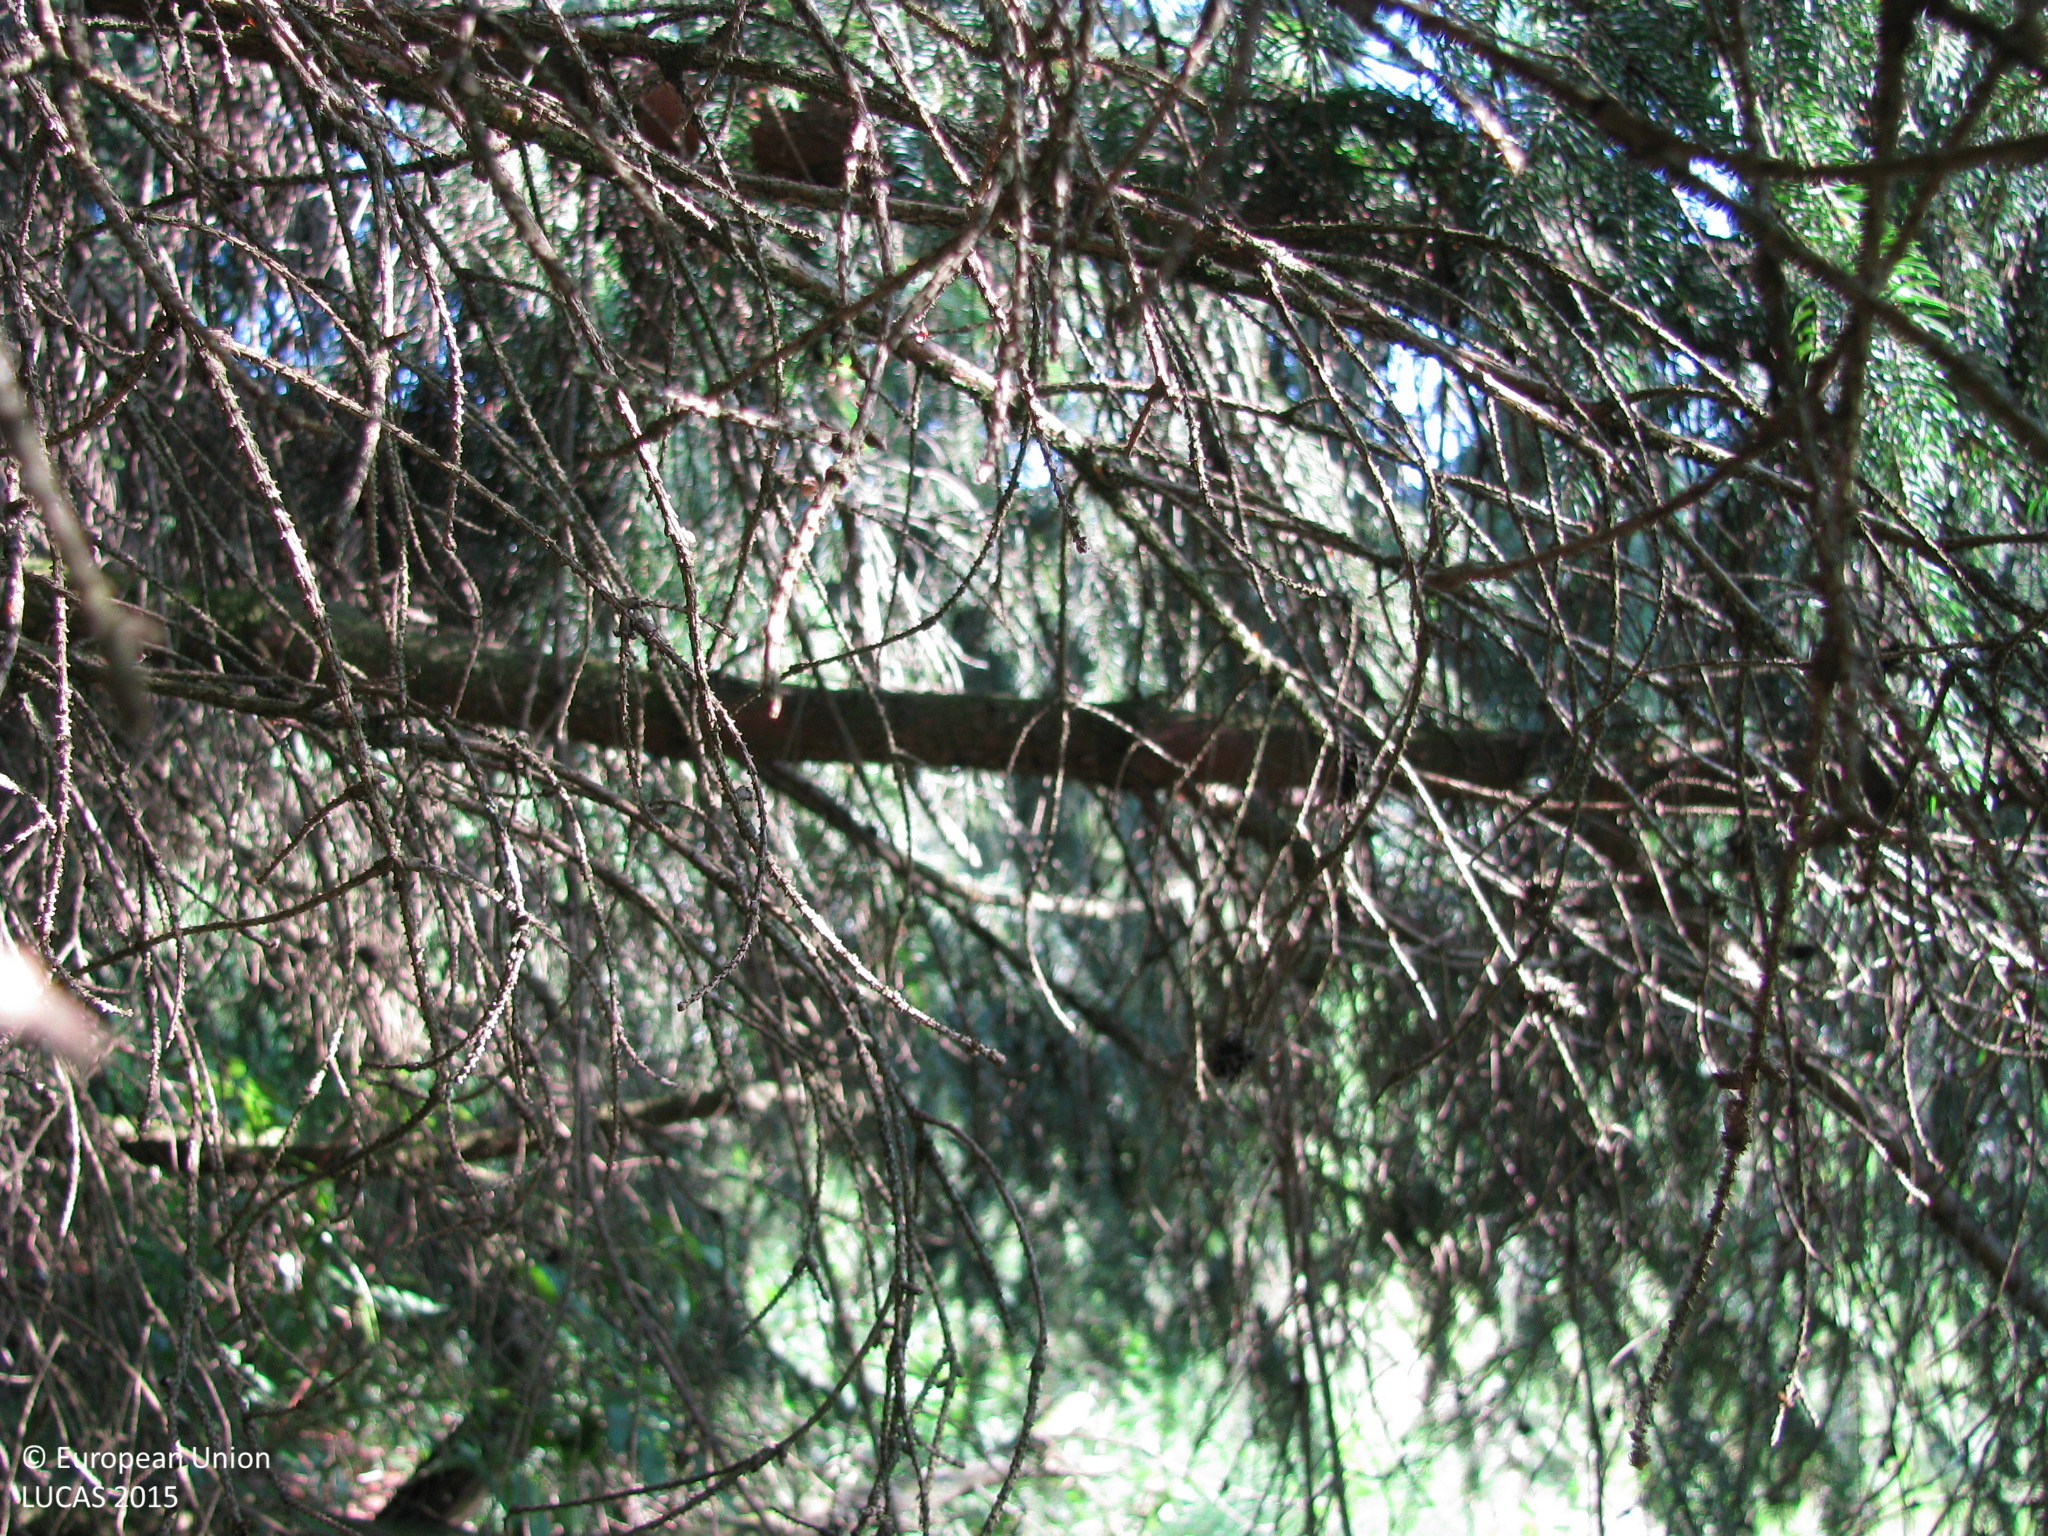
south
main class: Woodland
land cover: Spruce dominated coniferous woodland
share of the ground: > 75 %
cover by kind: coniferous forest trees 95 %, herbaceous plants 5 %
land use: Forestry
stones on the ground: < 10 %
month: July
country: AT
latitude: 47.1628
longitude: 14.8138
